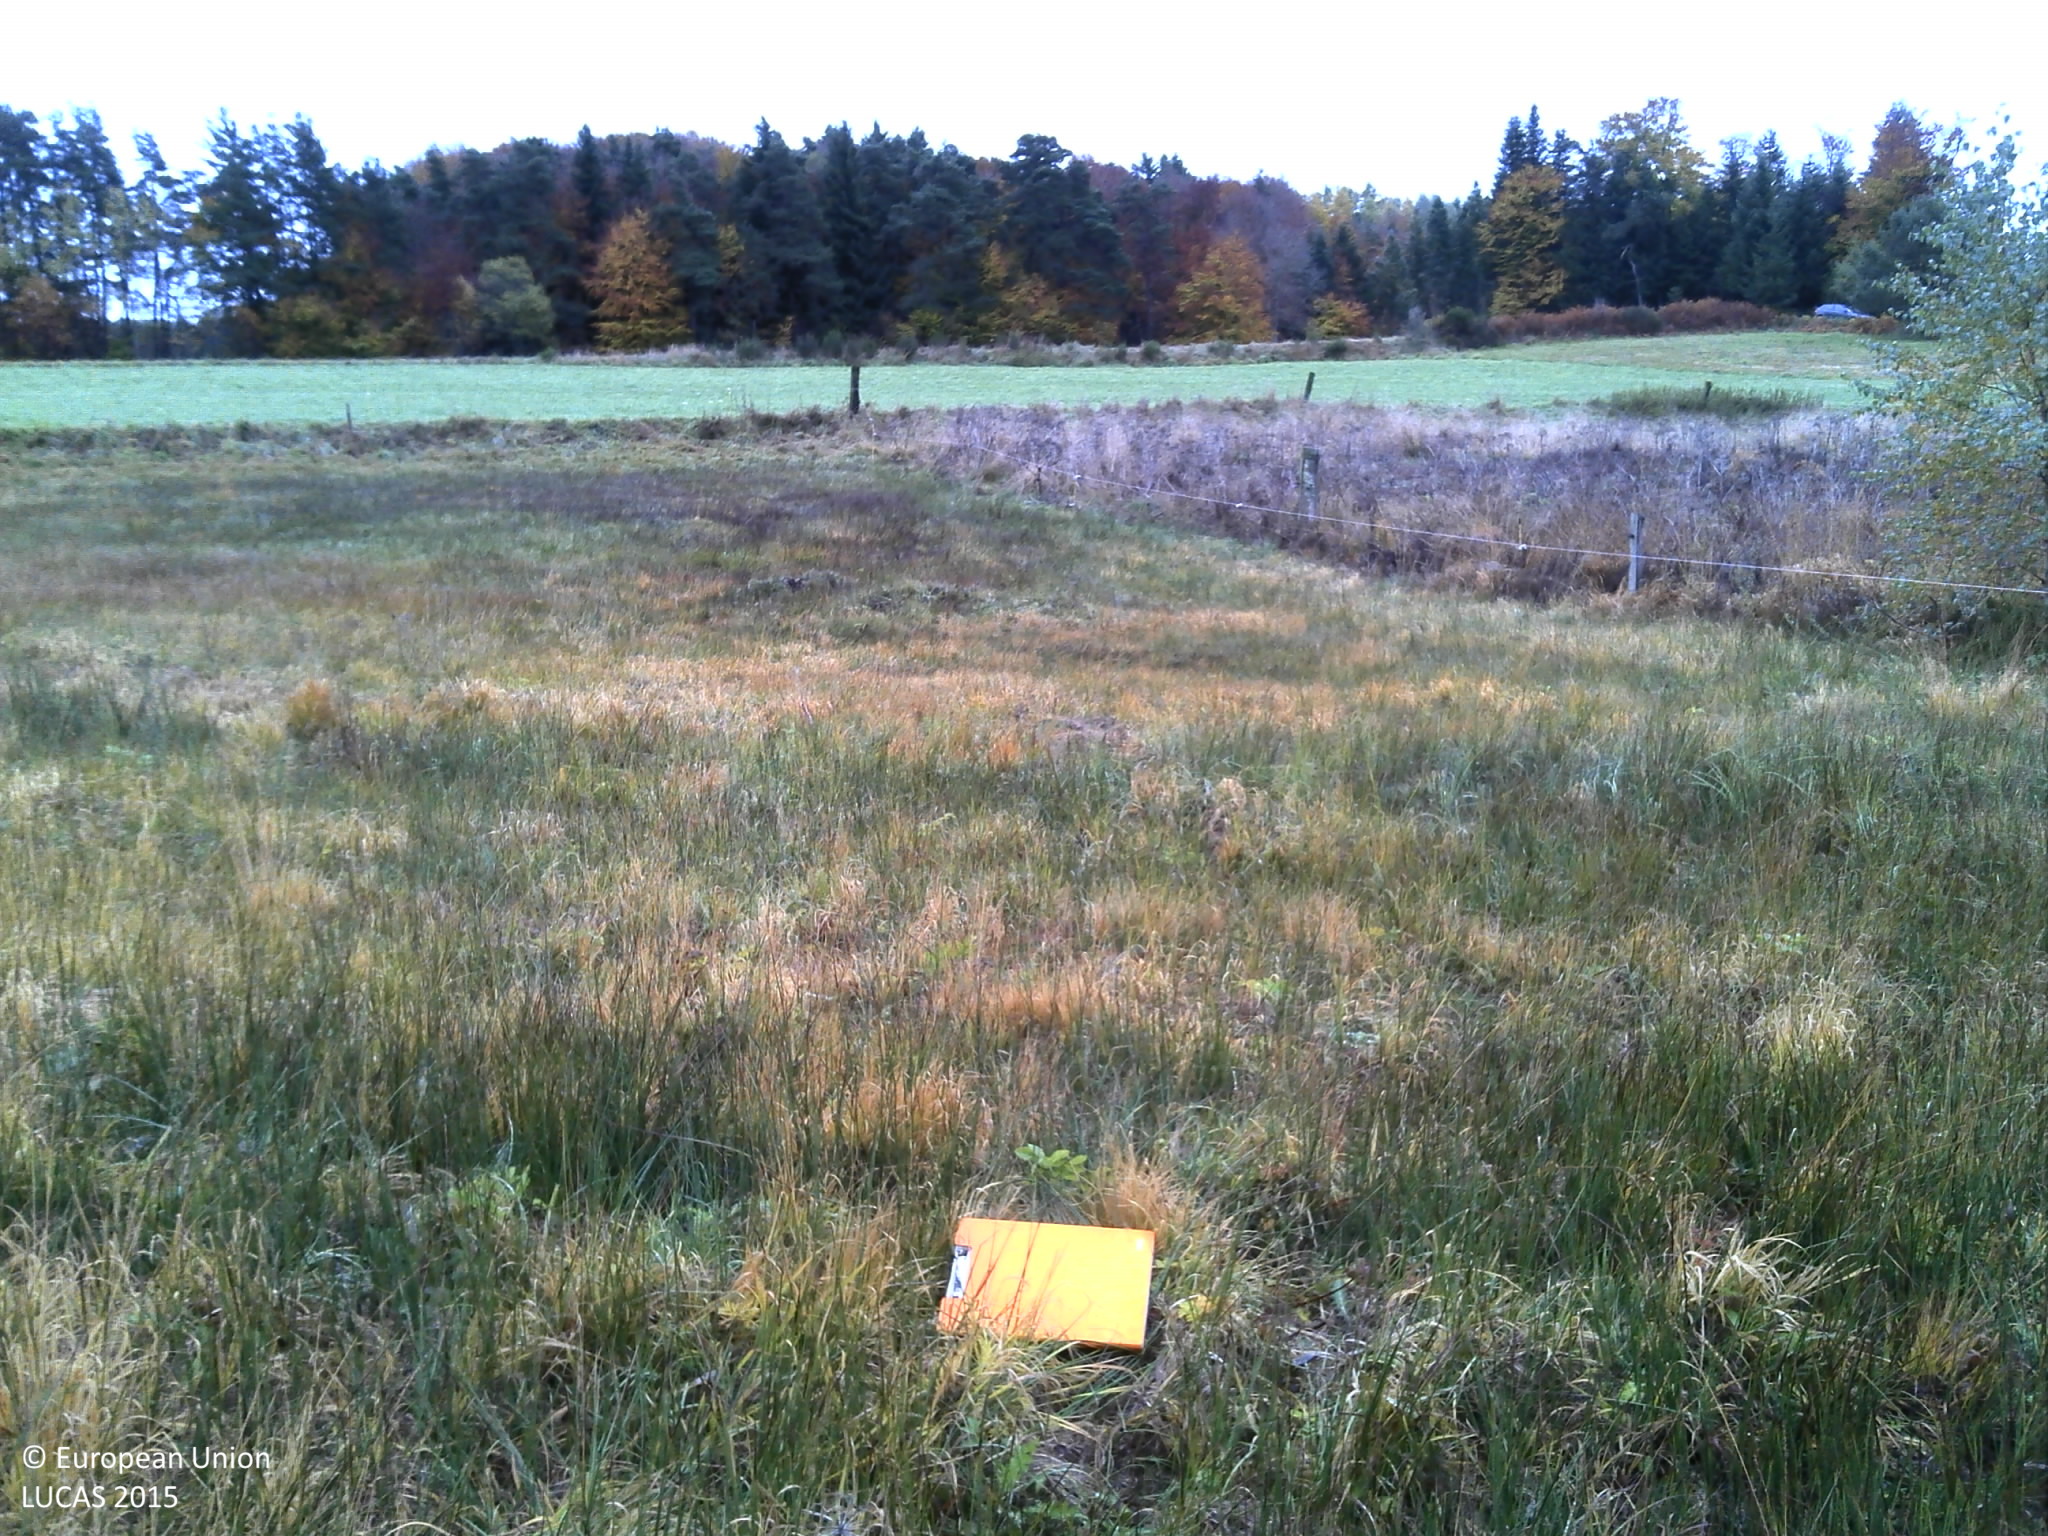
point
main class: Grassland
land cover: Grassland without tree/shrub cover
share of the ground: > 75 %
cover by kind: herbaceous plants 100 %
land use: Agriculture (excluding fallow land and kitchen gardens)
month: October
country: FR
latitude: 45.4143
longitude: 3.8310
